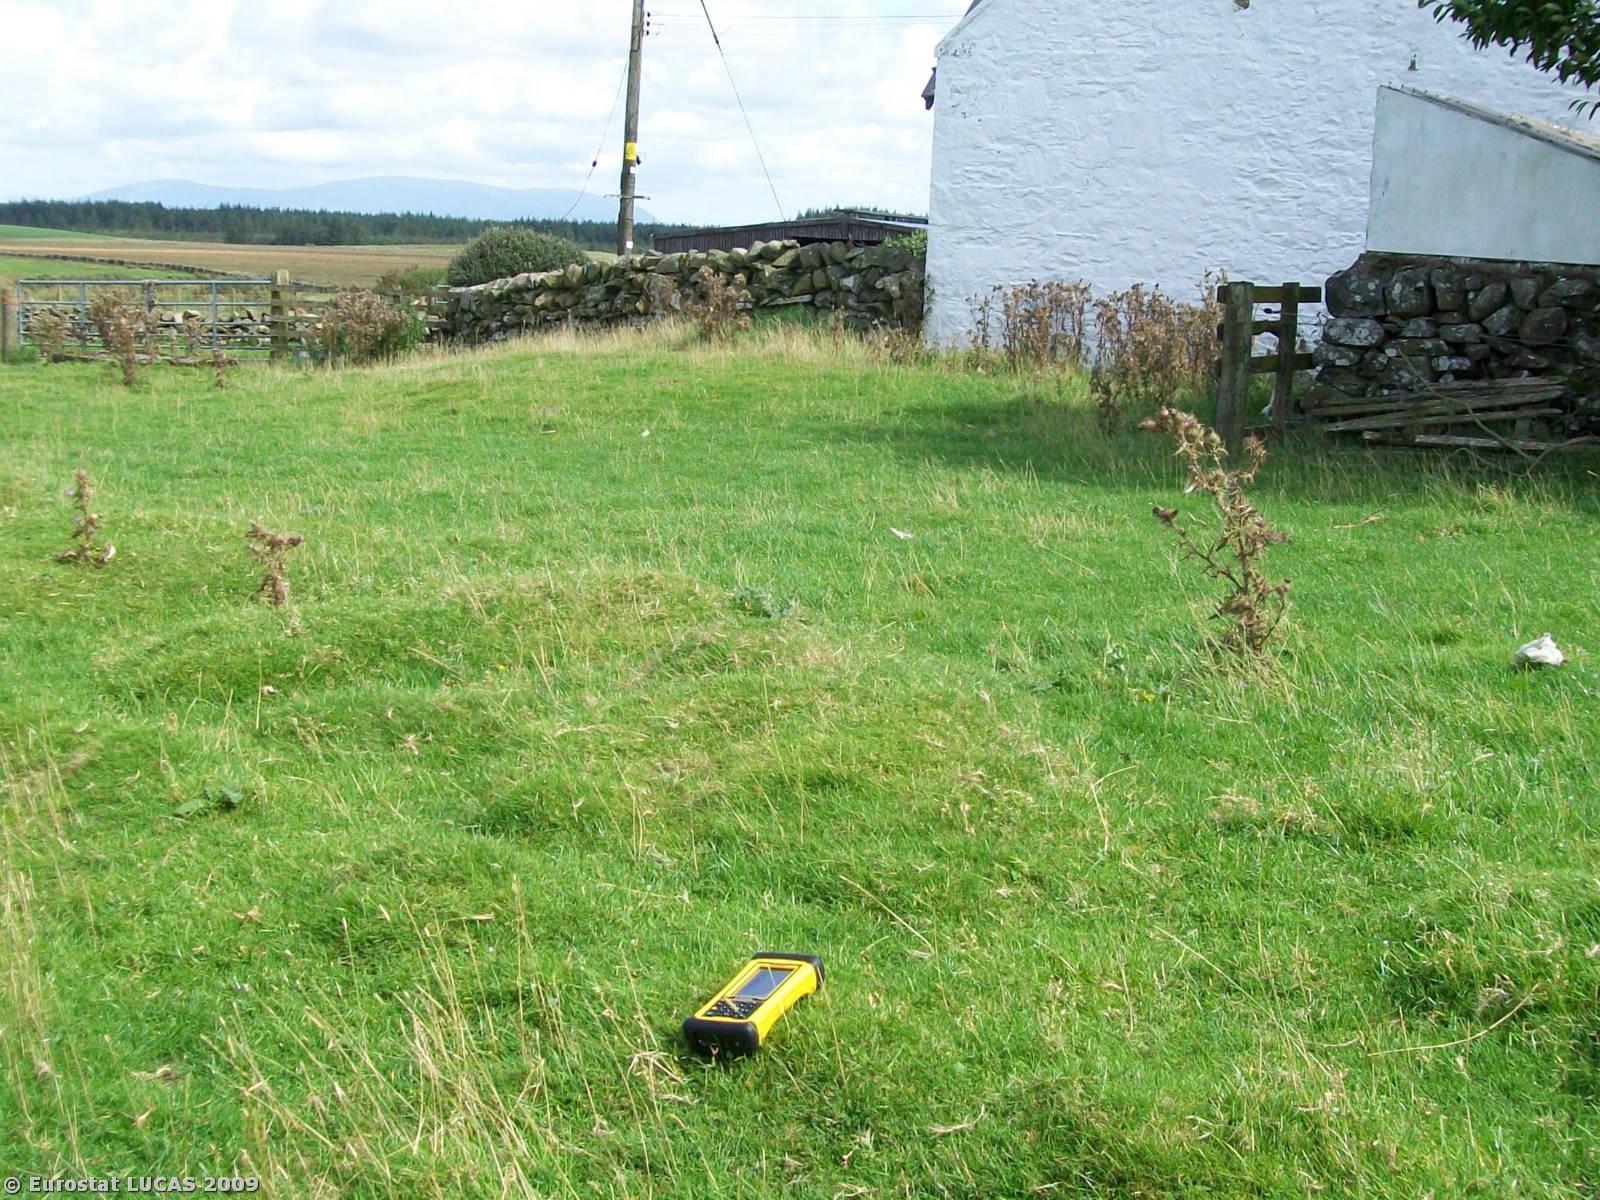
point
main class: Grassland
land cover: Grassland without tree/shrub cover
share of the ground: < 10 %
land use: Agriculture (excluding fallow land and kitchen gardens)
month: August
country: GB
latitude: 54.8932
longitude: -4.7163
